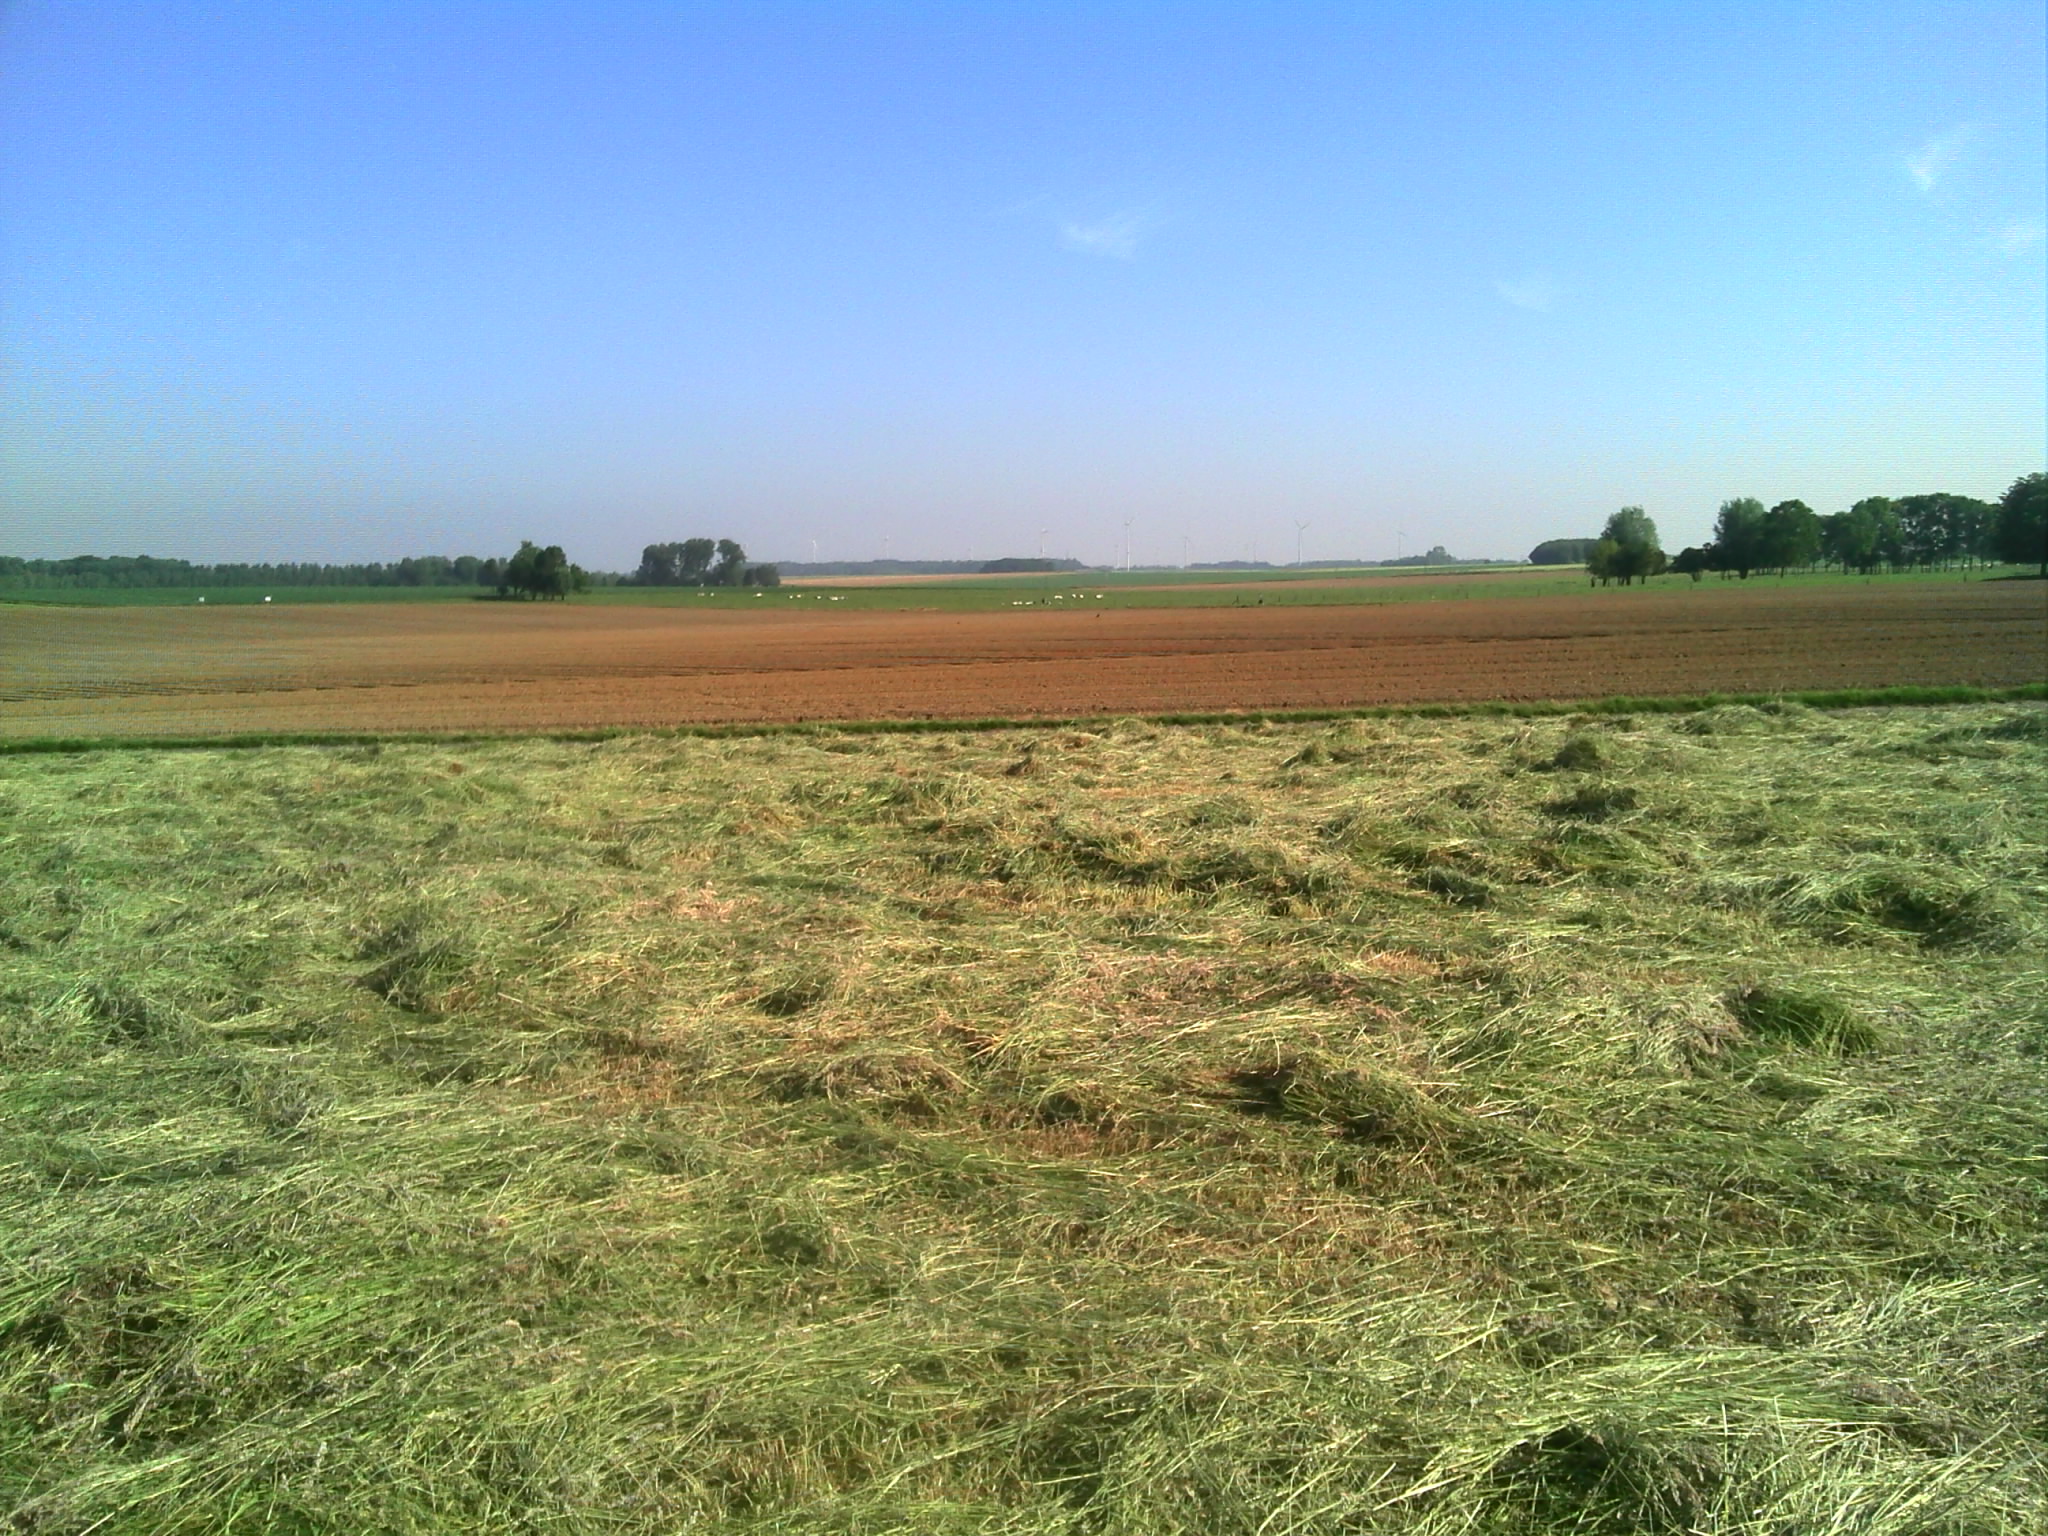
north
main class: Grassland
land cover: Grassland without tree/shrub cover
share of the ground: > 75 %
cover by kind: herbaceous plants 100 %
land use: Agriculture (excluding fallow land and kitchen gardens)
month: June
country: BE
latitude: 50.5516
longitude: 4.7886
